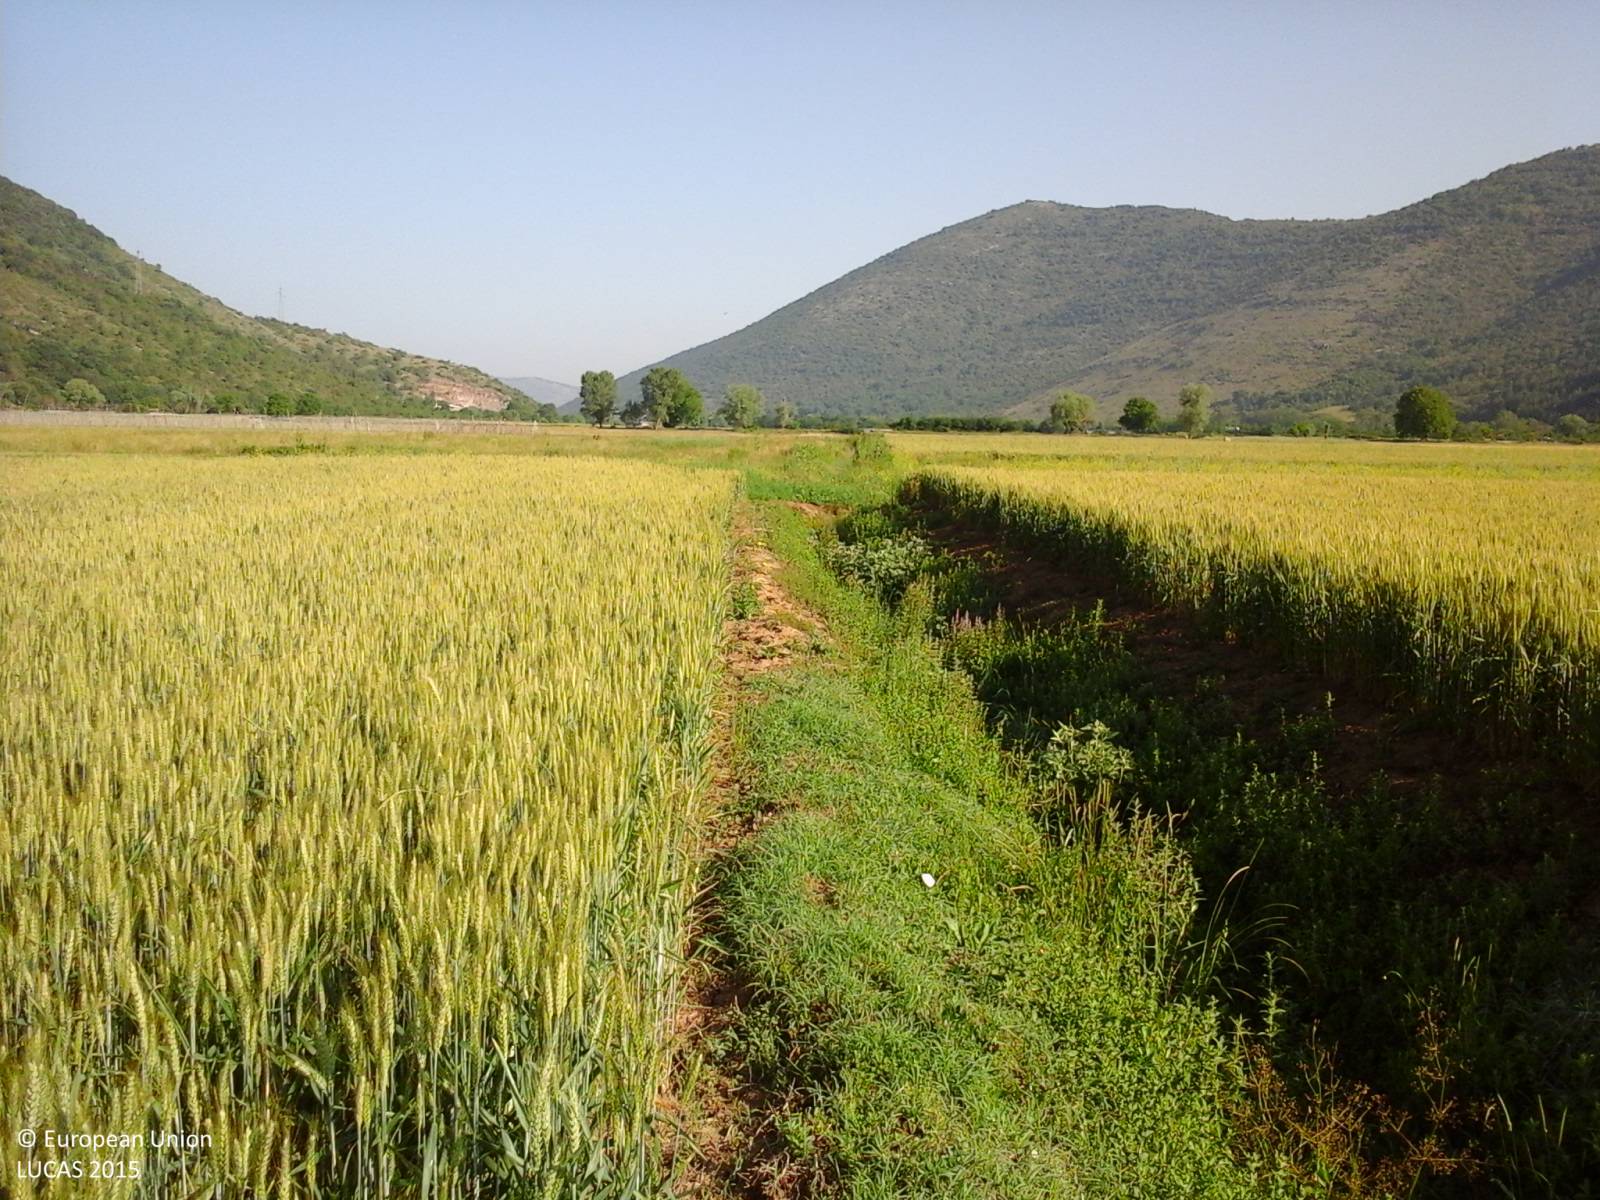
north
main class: Cropland
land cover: Durum wheat
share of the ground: > 75 %
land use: Agriculture (excluding fallow land and kitchen gardens)
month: June
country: IT
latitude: 42.0928
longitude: 13.3376
